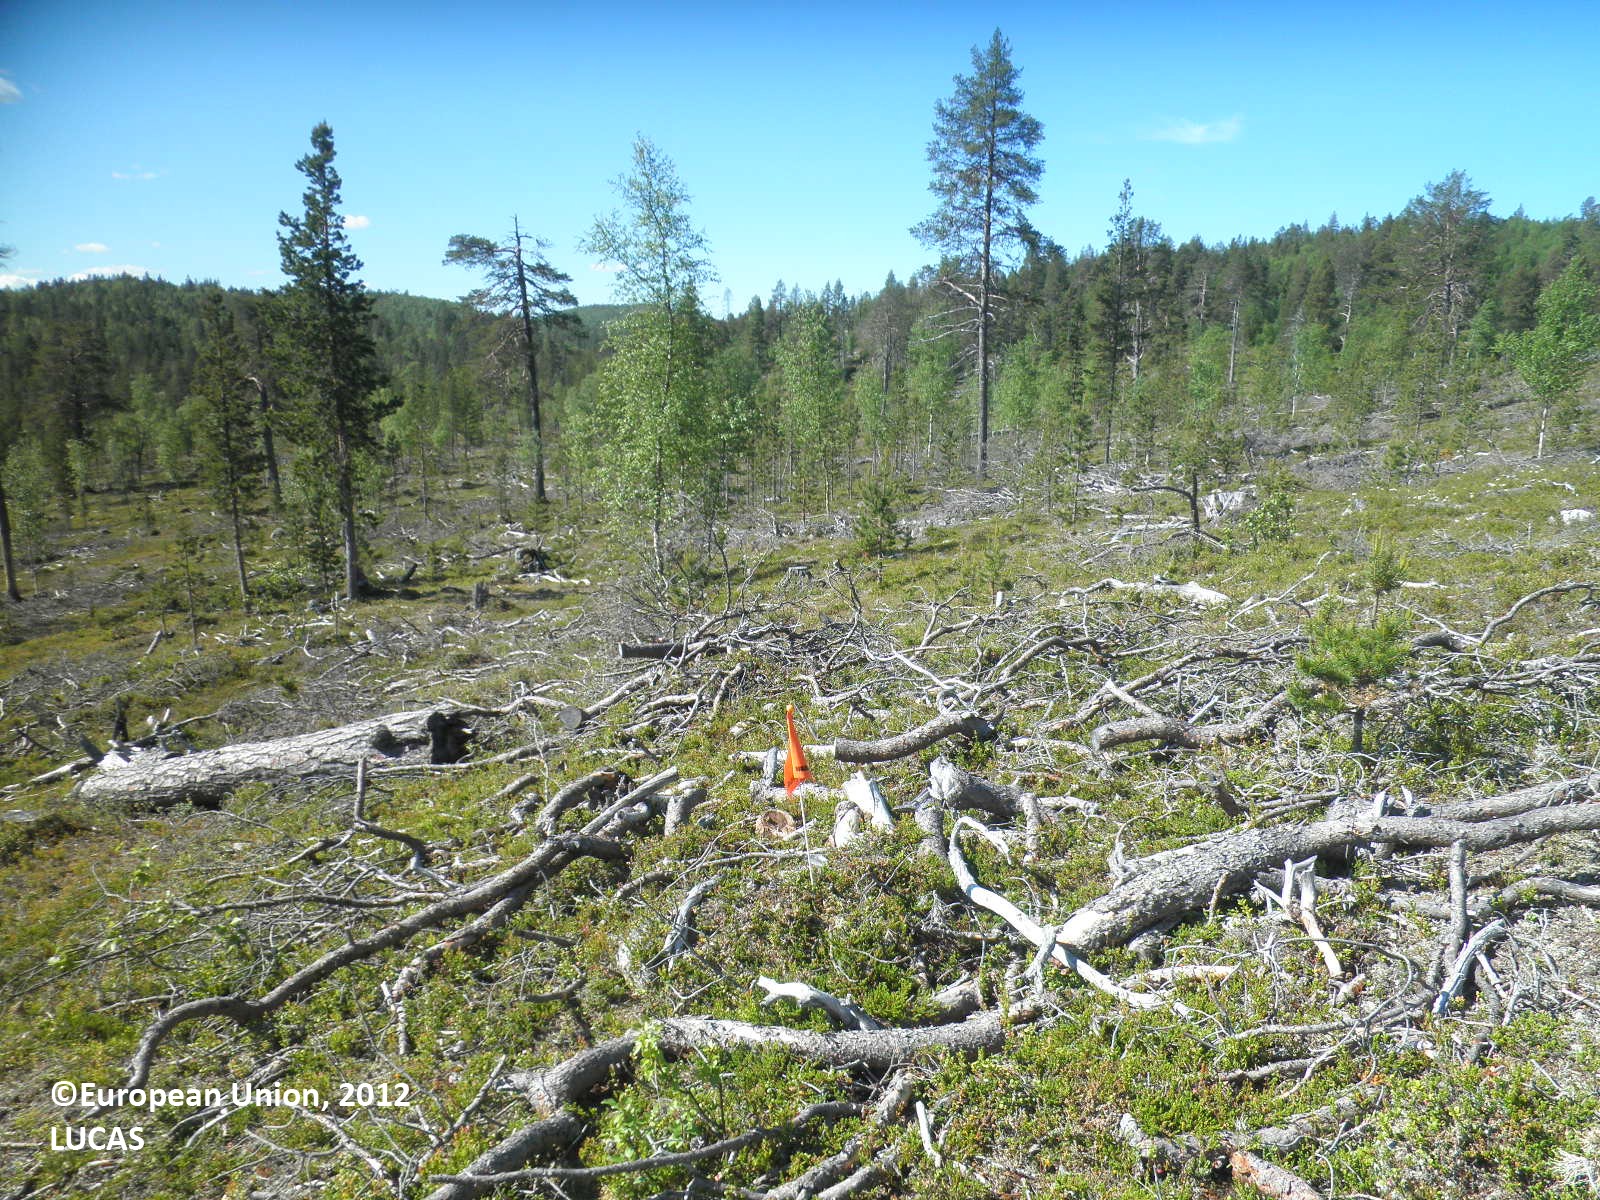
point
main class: Shrubland
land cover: Shrubland with sparse tree cover
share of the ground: 50 - 75 %
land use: Forestry
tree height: < 5 m
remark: Clear cut
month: July
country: FI
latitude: 68.7971
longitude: 26.6271
